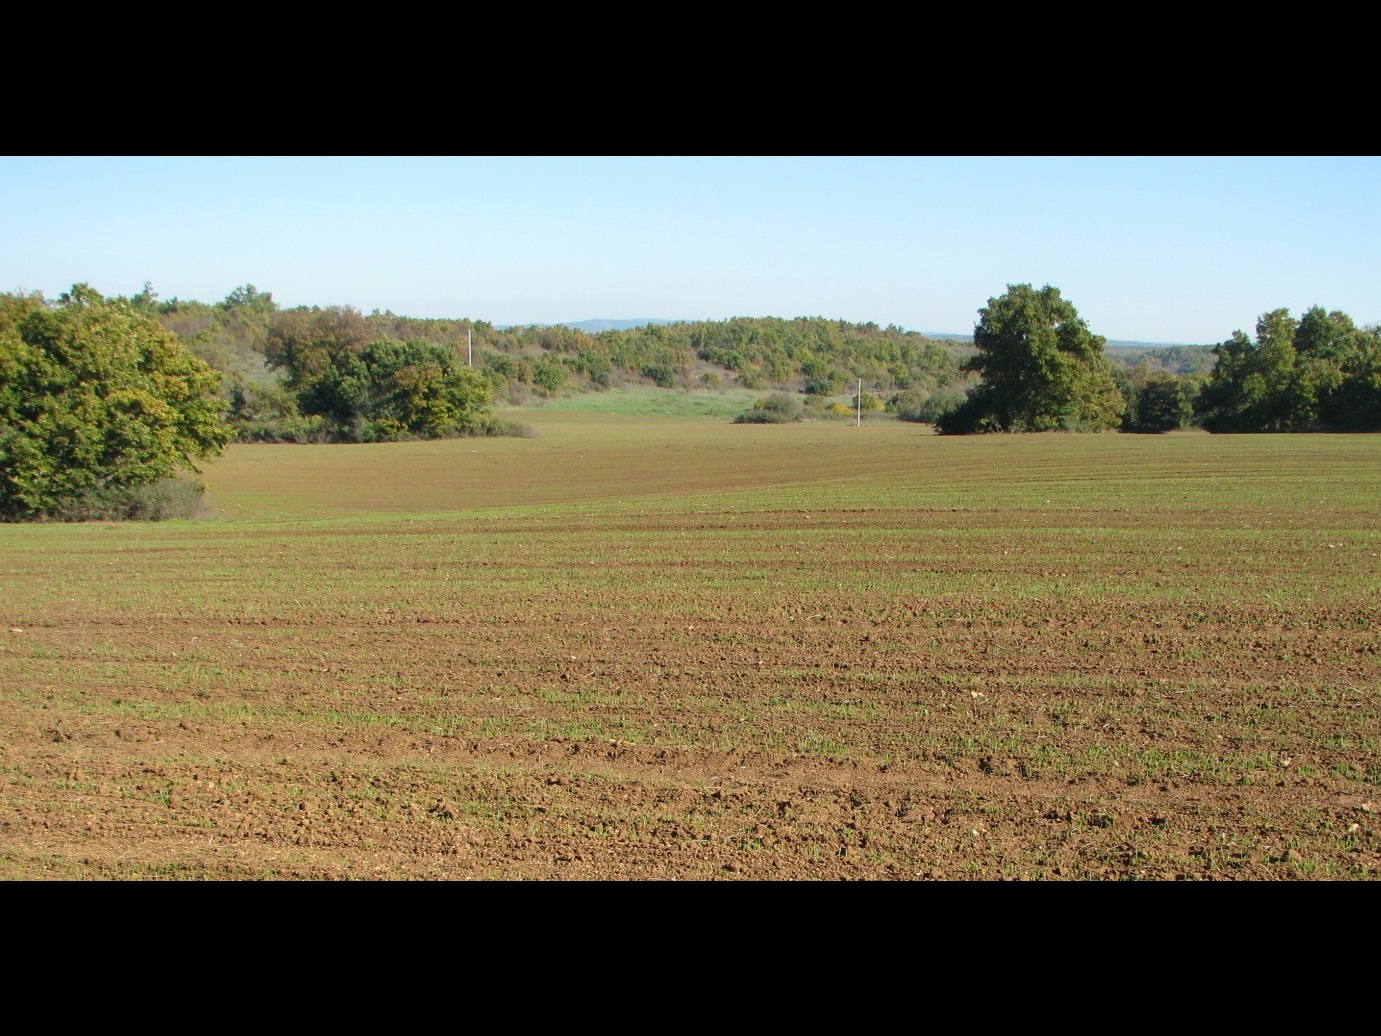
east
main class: Cropland
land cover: Common wheat
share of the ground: 10 - 25 %
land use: Agriculture (excluding fallow land and kitchen gardens)
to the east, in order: Common wheat; Single bushes/trees; Common wheat; Single bushes/trees; Common wheat; Single bushes/trees; Common wheat; Electric lines; Common wheat
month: November
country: BG
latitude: 42.0363
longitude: 26.8738
